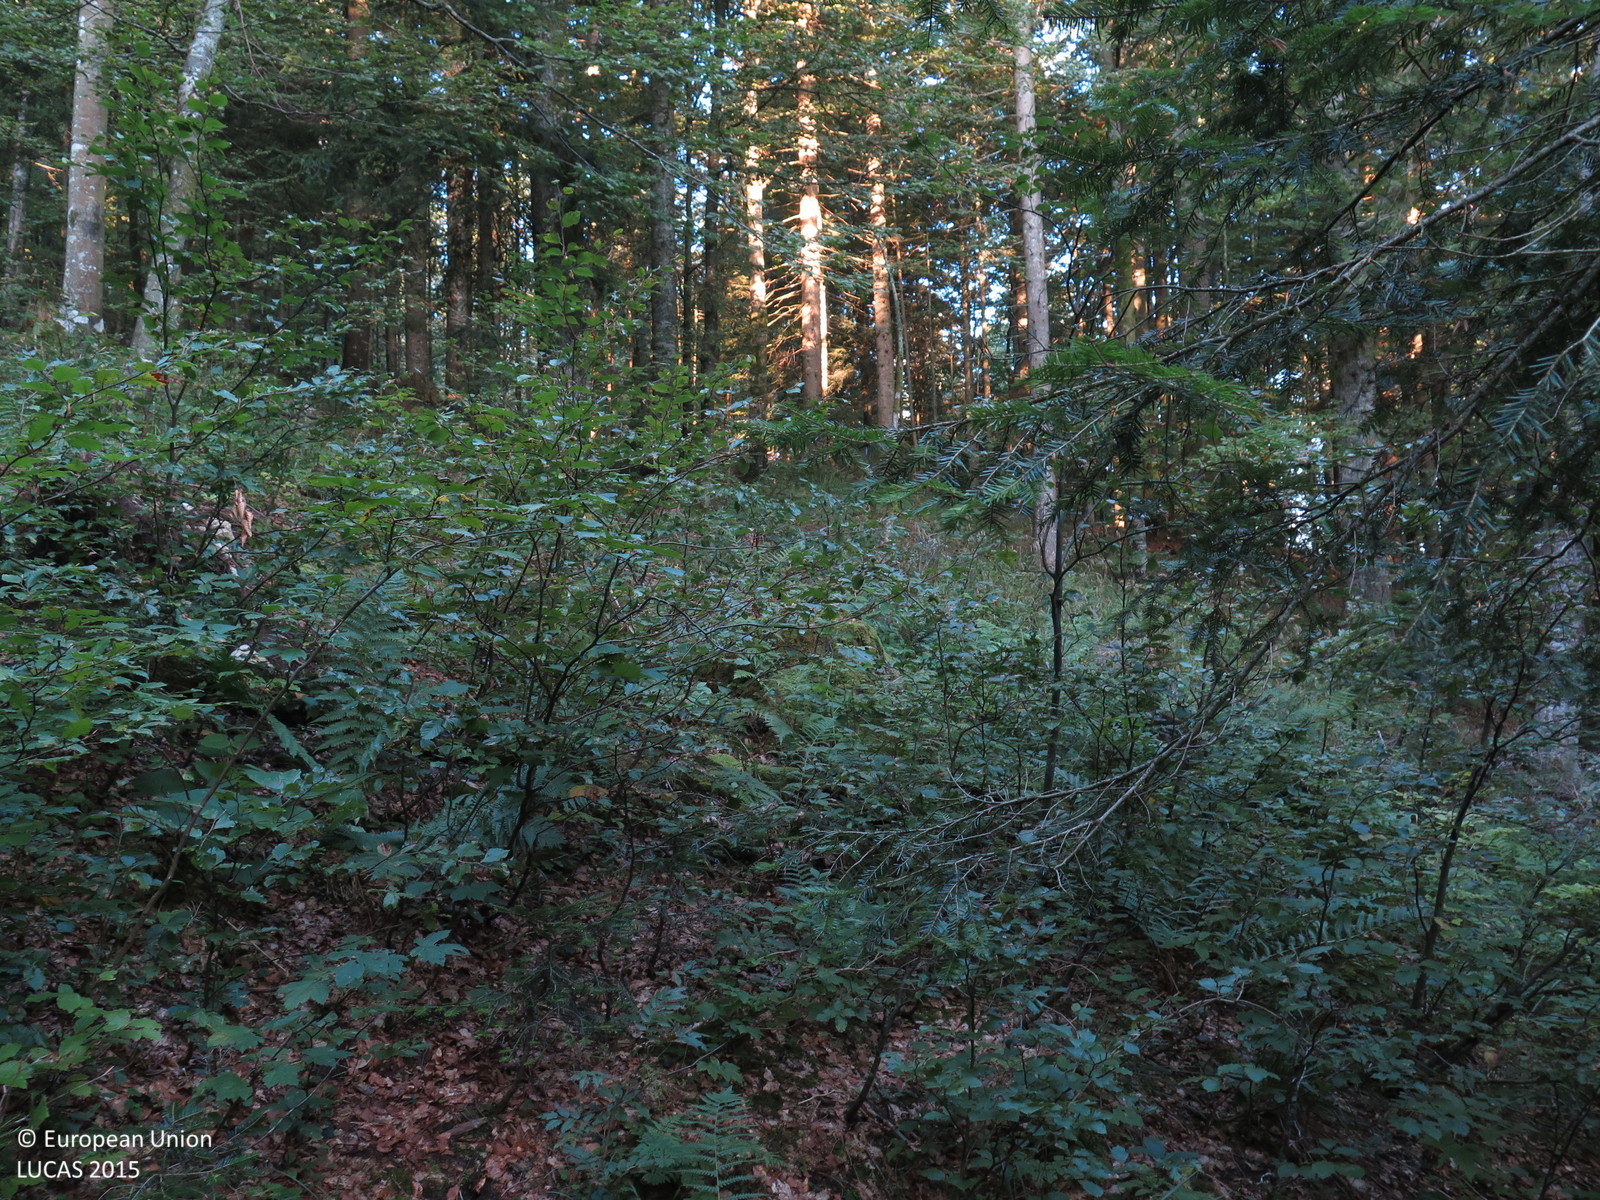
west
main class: Woodland
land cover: Other mixed woodland
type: mountainous beech forest
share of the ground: > 75 %
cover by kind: broadleaved forest trees 75 %, coniferous forest trees 25 %
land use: Forestry
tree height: > 5 m
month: August
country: HR
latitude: 45.2978
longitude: 14.9557
